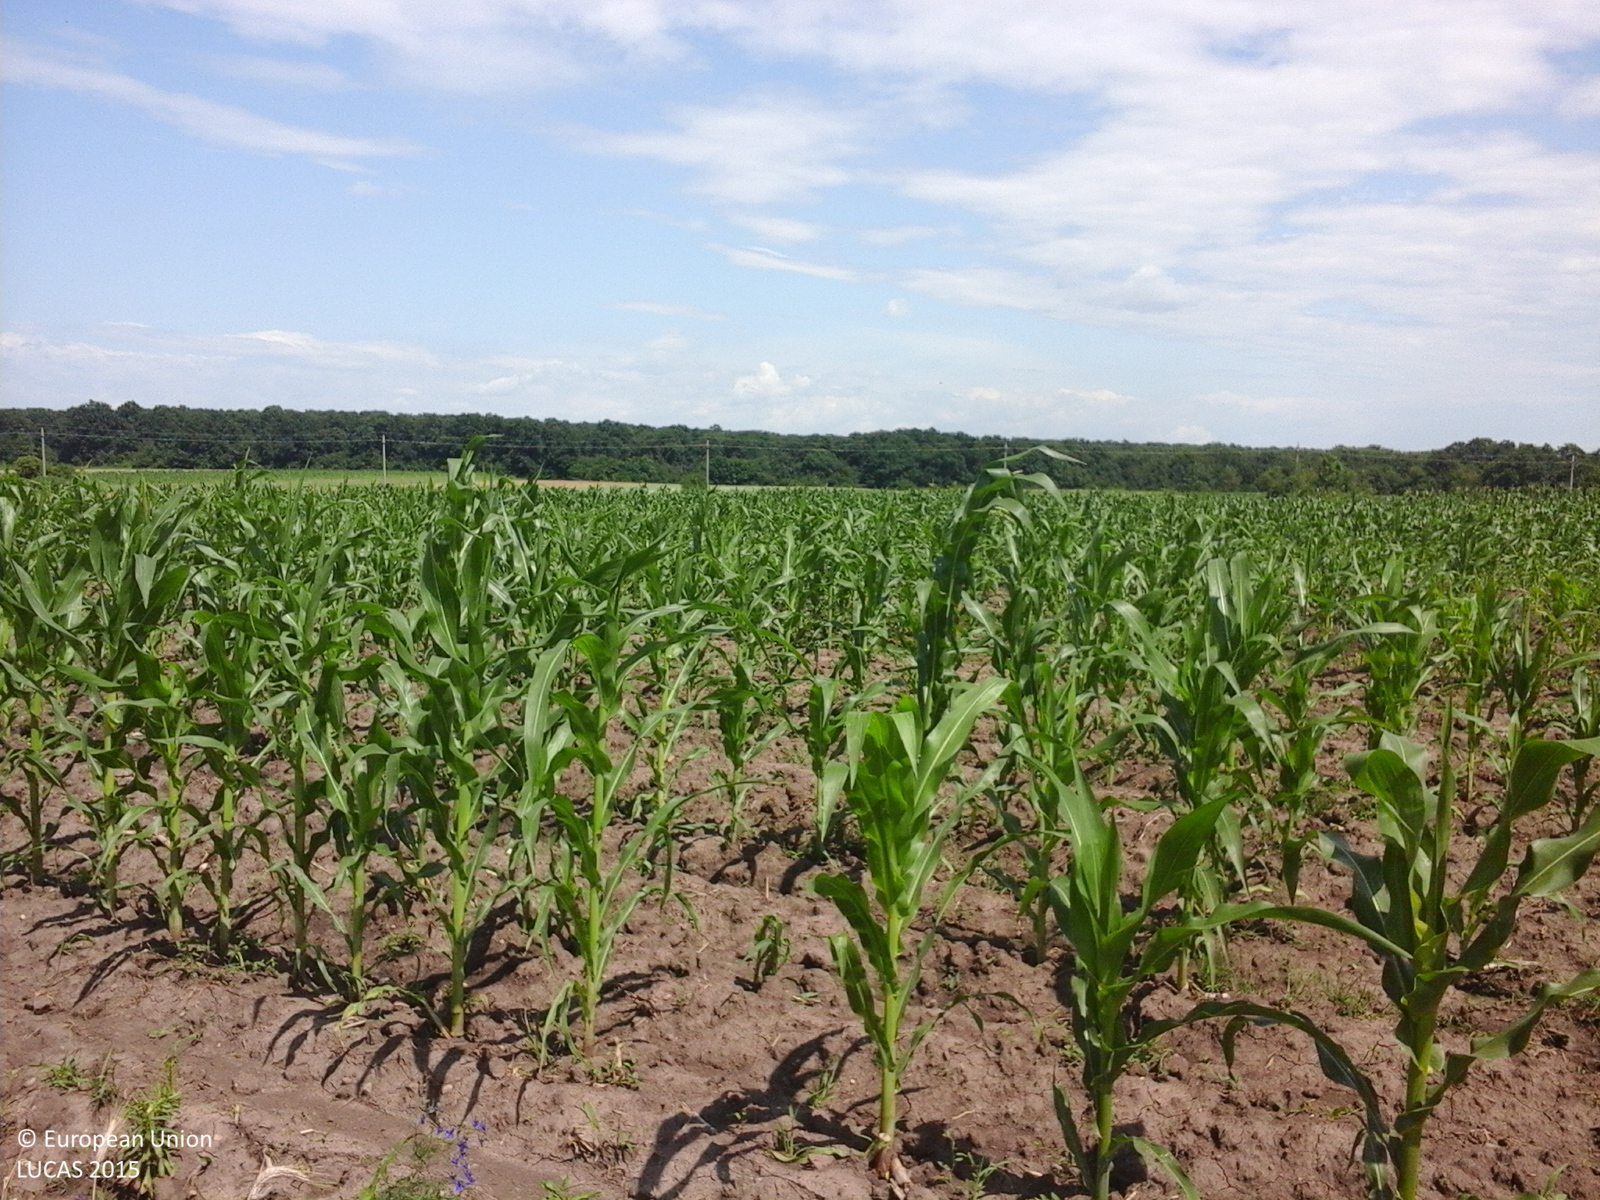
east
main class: Cropland
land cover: Common wheat
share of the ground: > 75 %
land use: Agriculture (excluding fallow land and kitchen gardens)
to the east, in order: Common wheat; Maize; Shrubland with sparse tree cover; Inland marshes; Tracks; Spontaneously vegetated surfaces; Other leguminous and mixtures for fodder; Oats; Electric lines
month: July
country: RO
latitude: 44.4416
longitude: 25.5080
